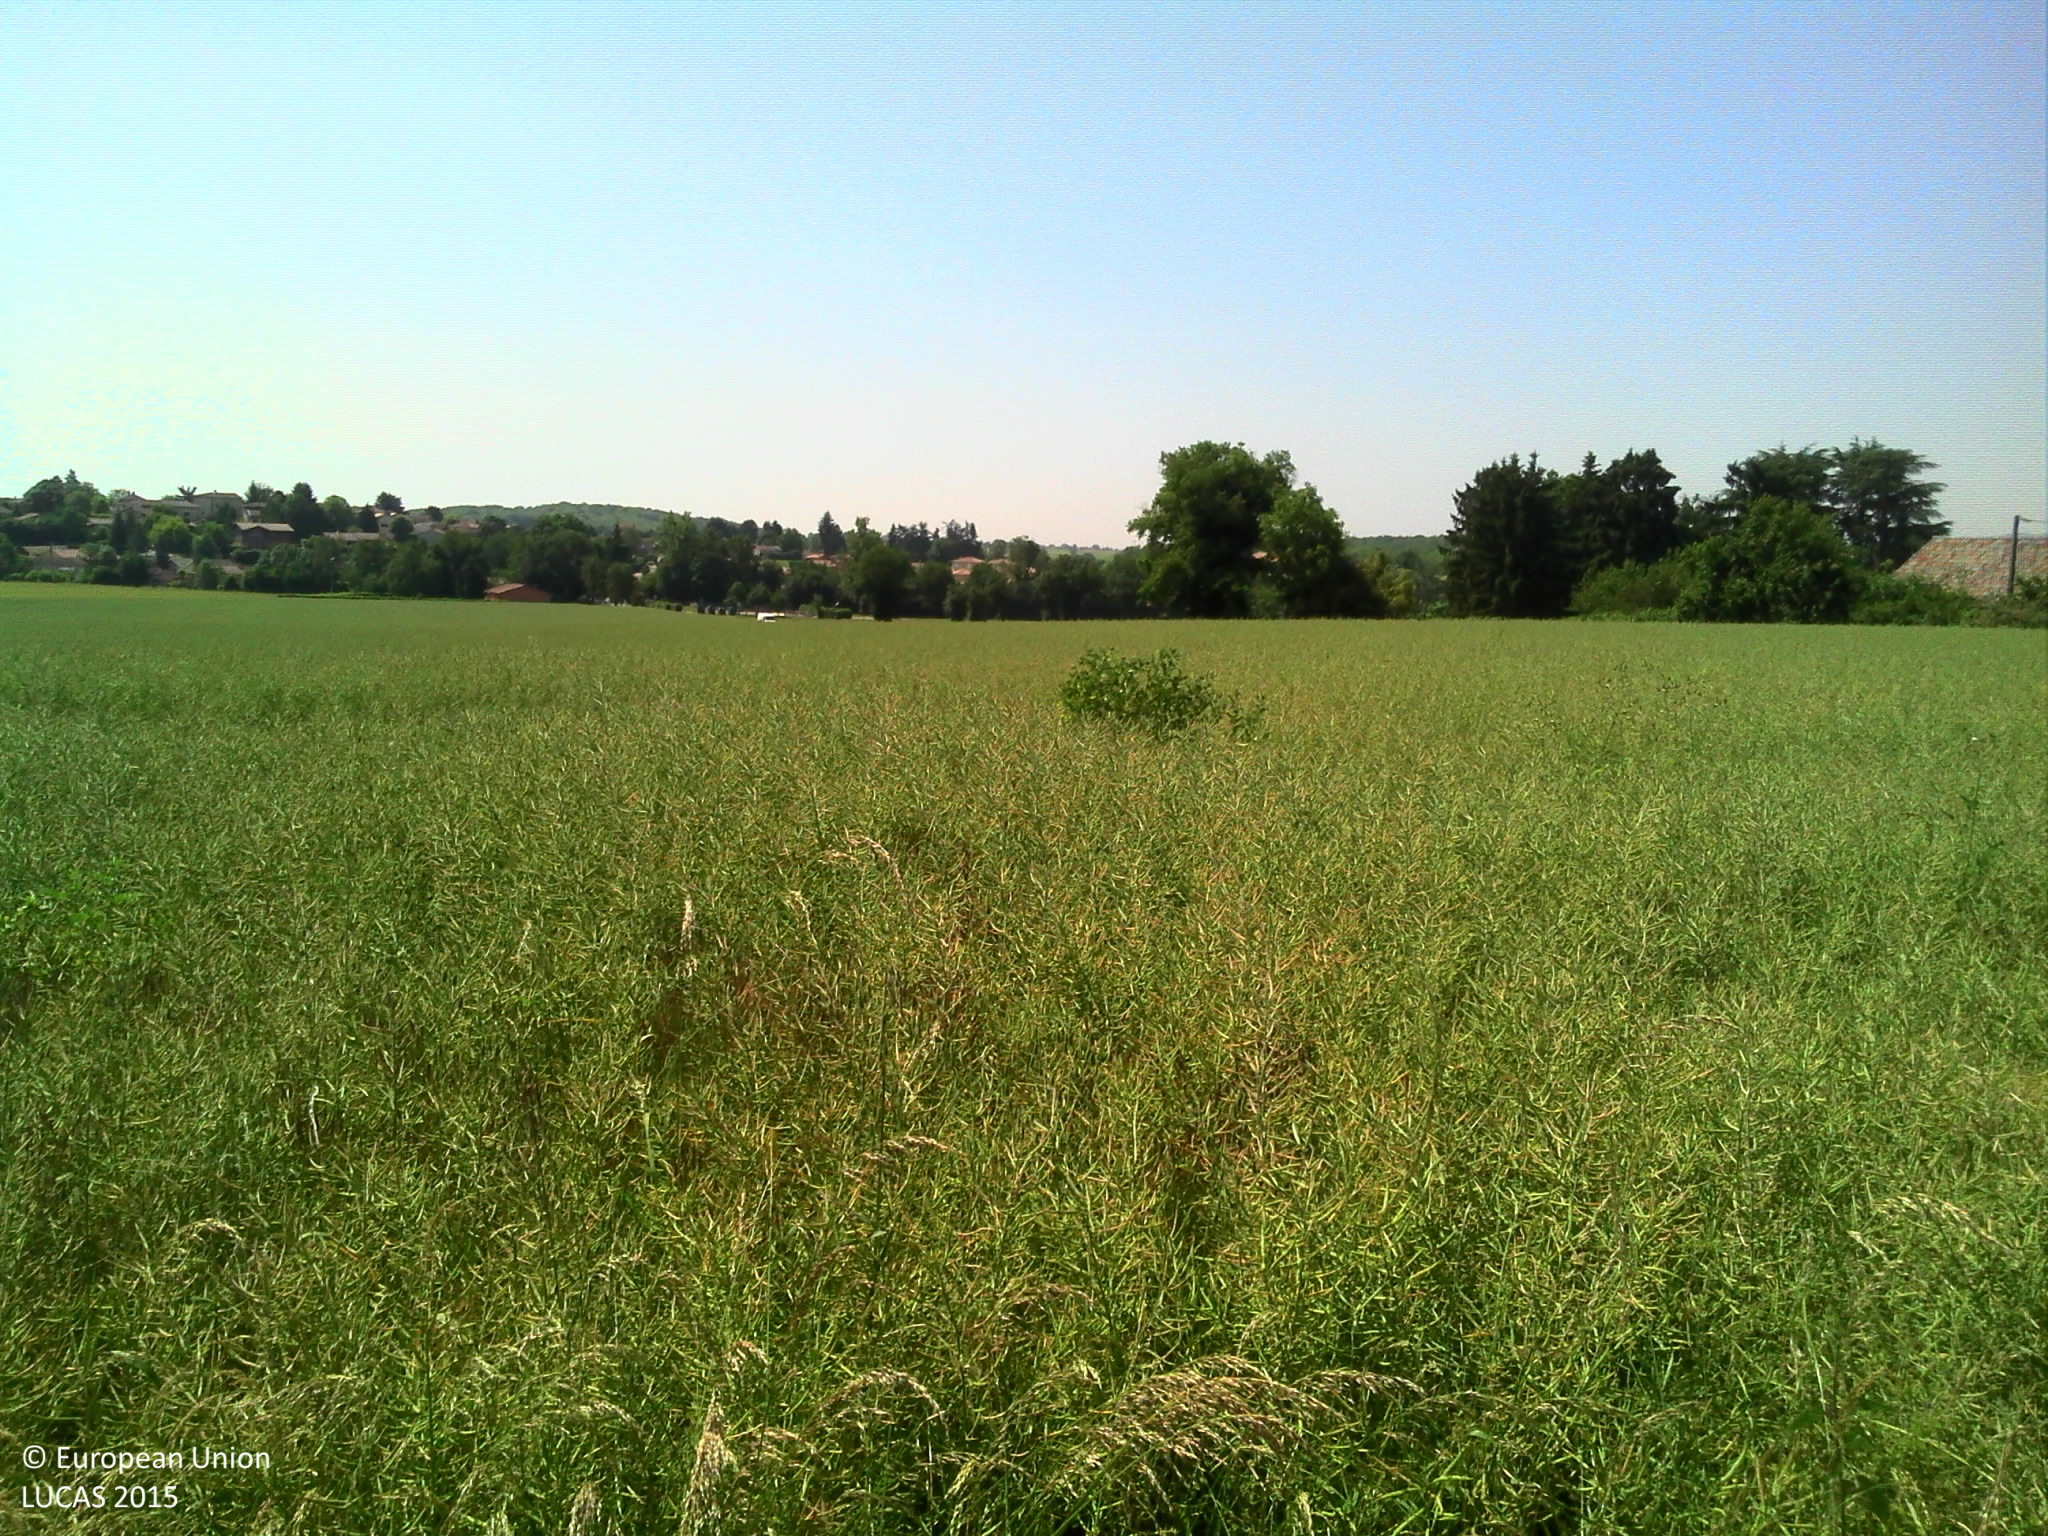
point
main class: Cropland
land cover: Rape and turnip rape
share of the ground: > 75 %
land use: Agriculture (excluding fallow land and kitchen gardens)
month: June
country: FR
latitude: 45.9579
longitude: 4.8808
